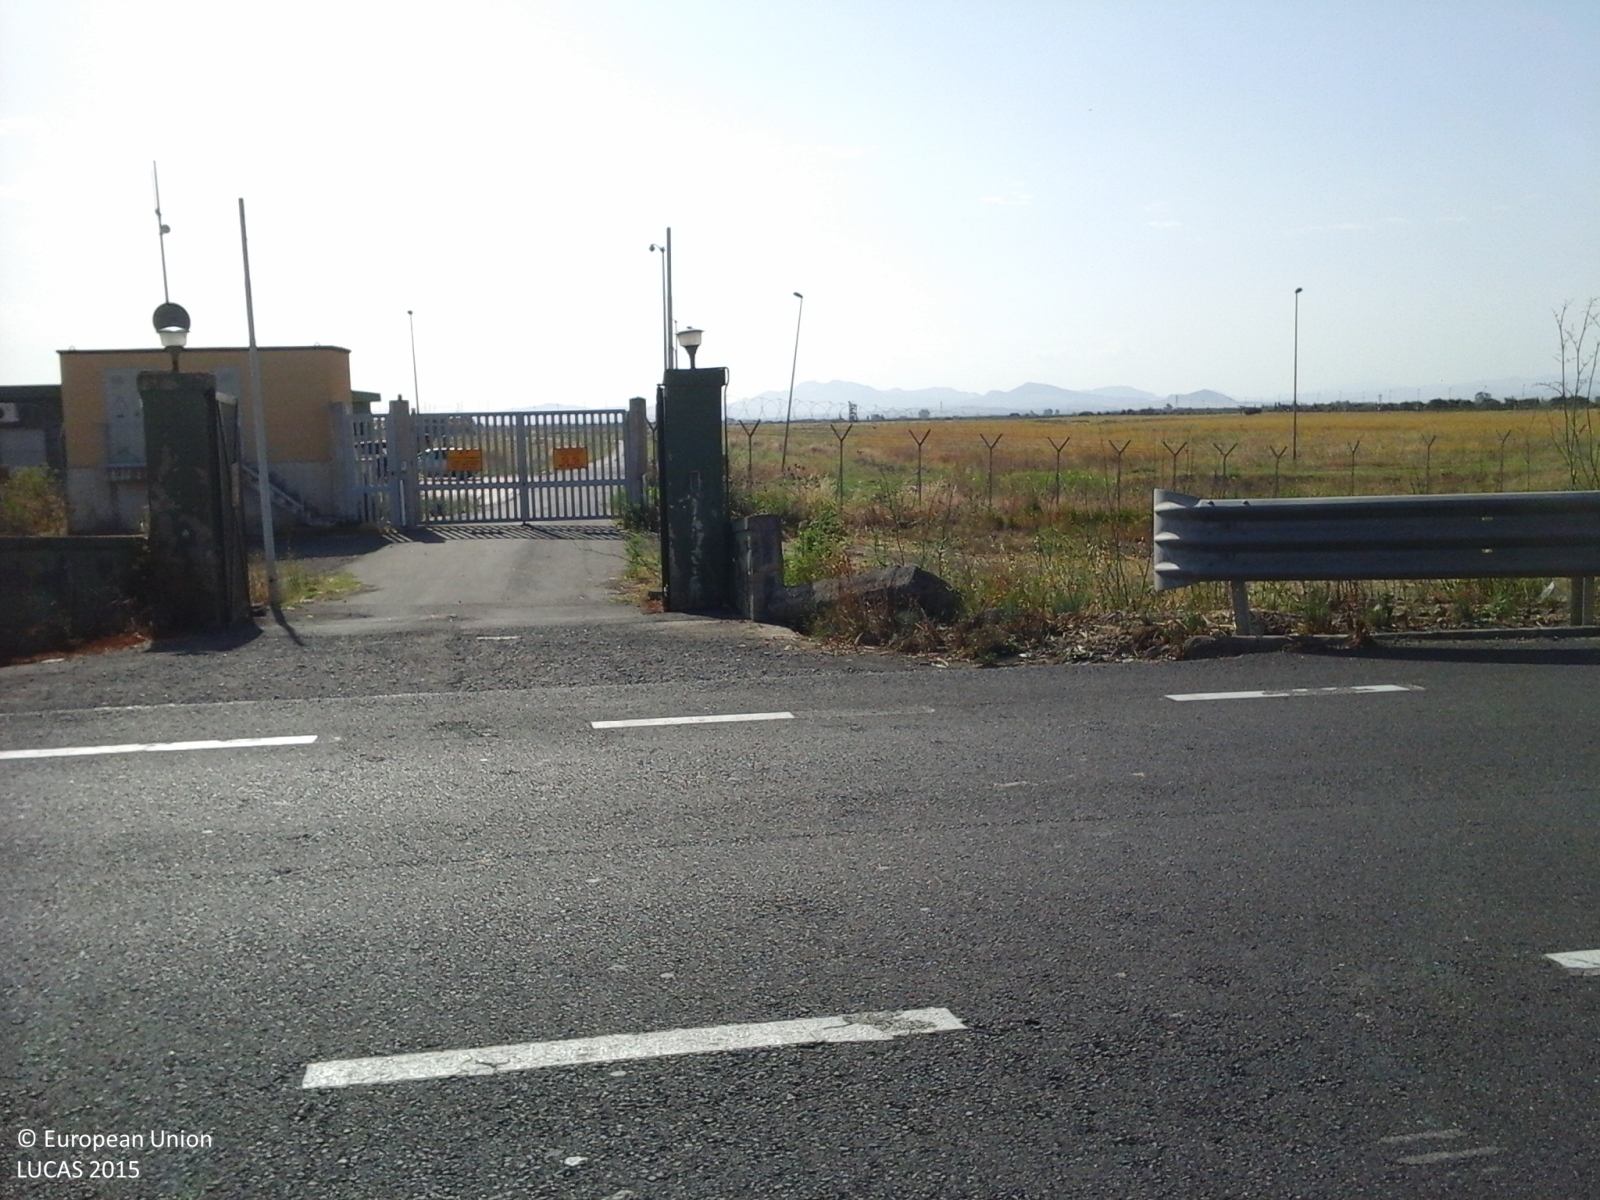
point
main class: Grassland
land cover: Spontaneously vegetated surfaces
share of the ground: > 75 %
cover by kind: herbaceous plants 100 %
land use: Community services
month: June
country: IT
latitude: 37.4041
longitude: 14.8784
